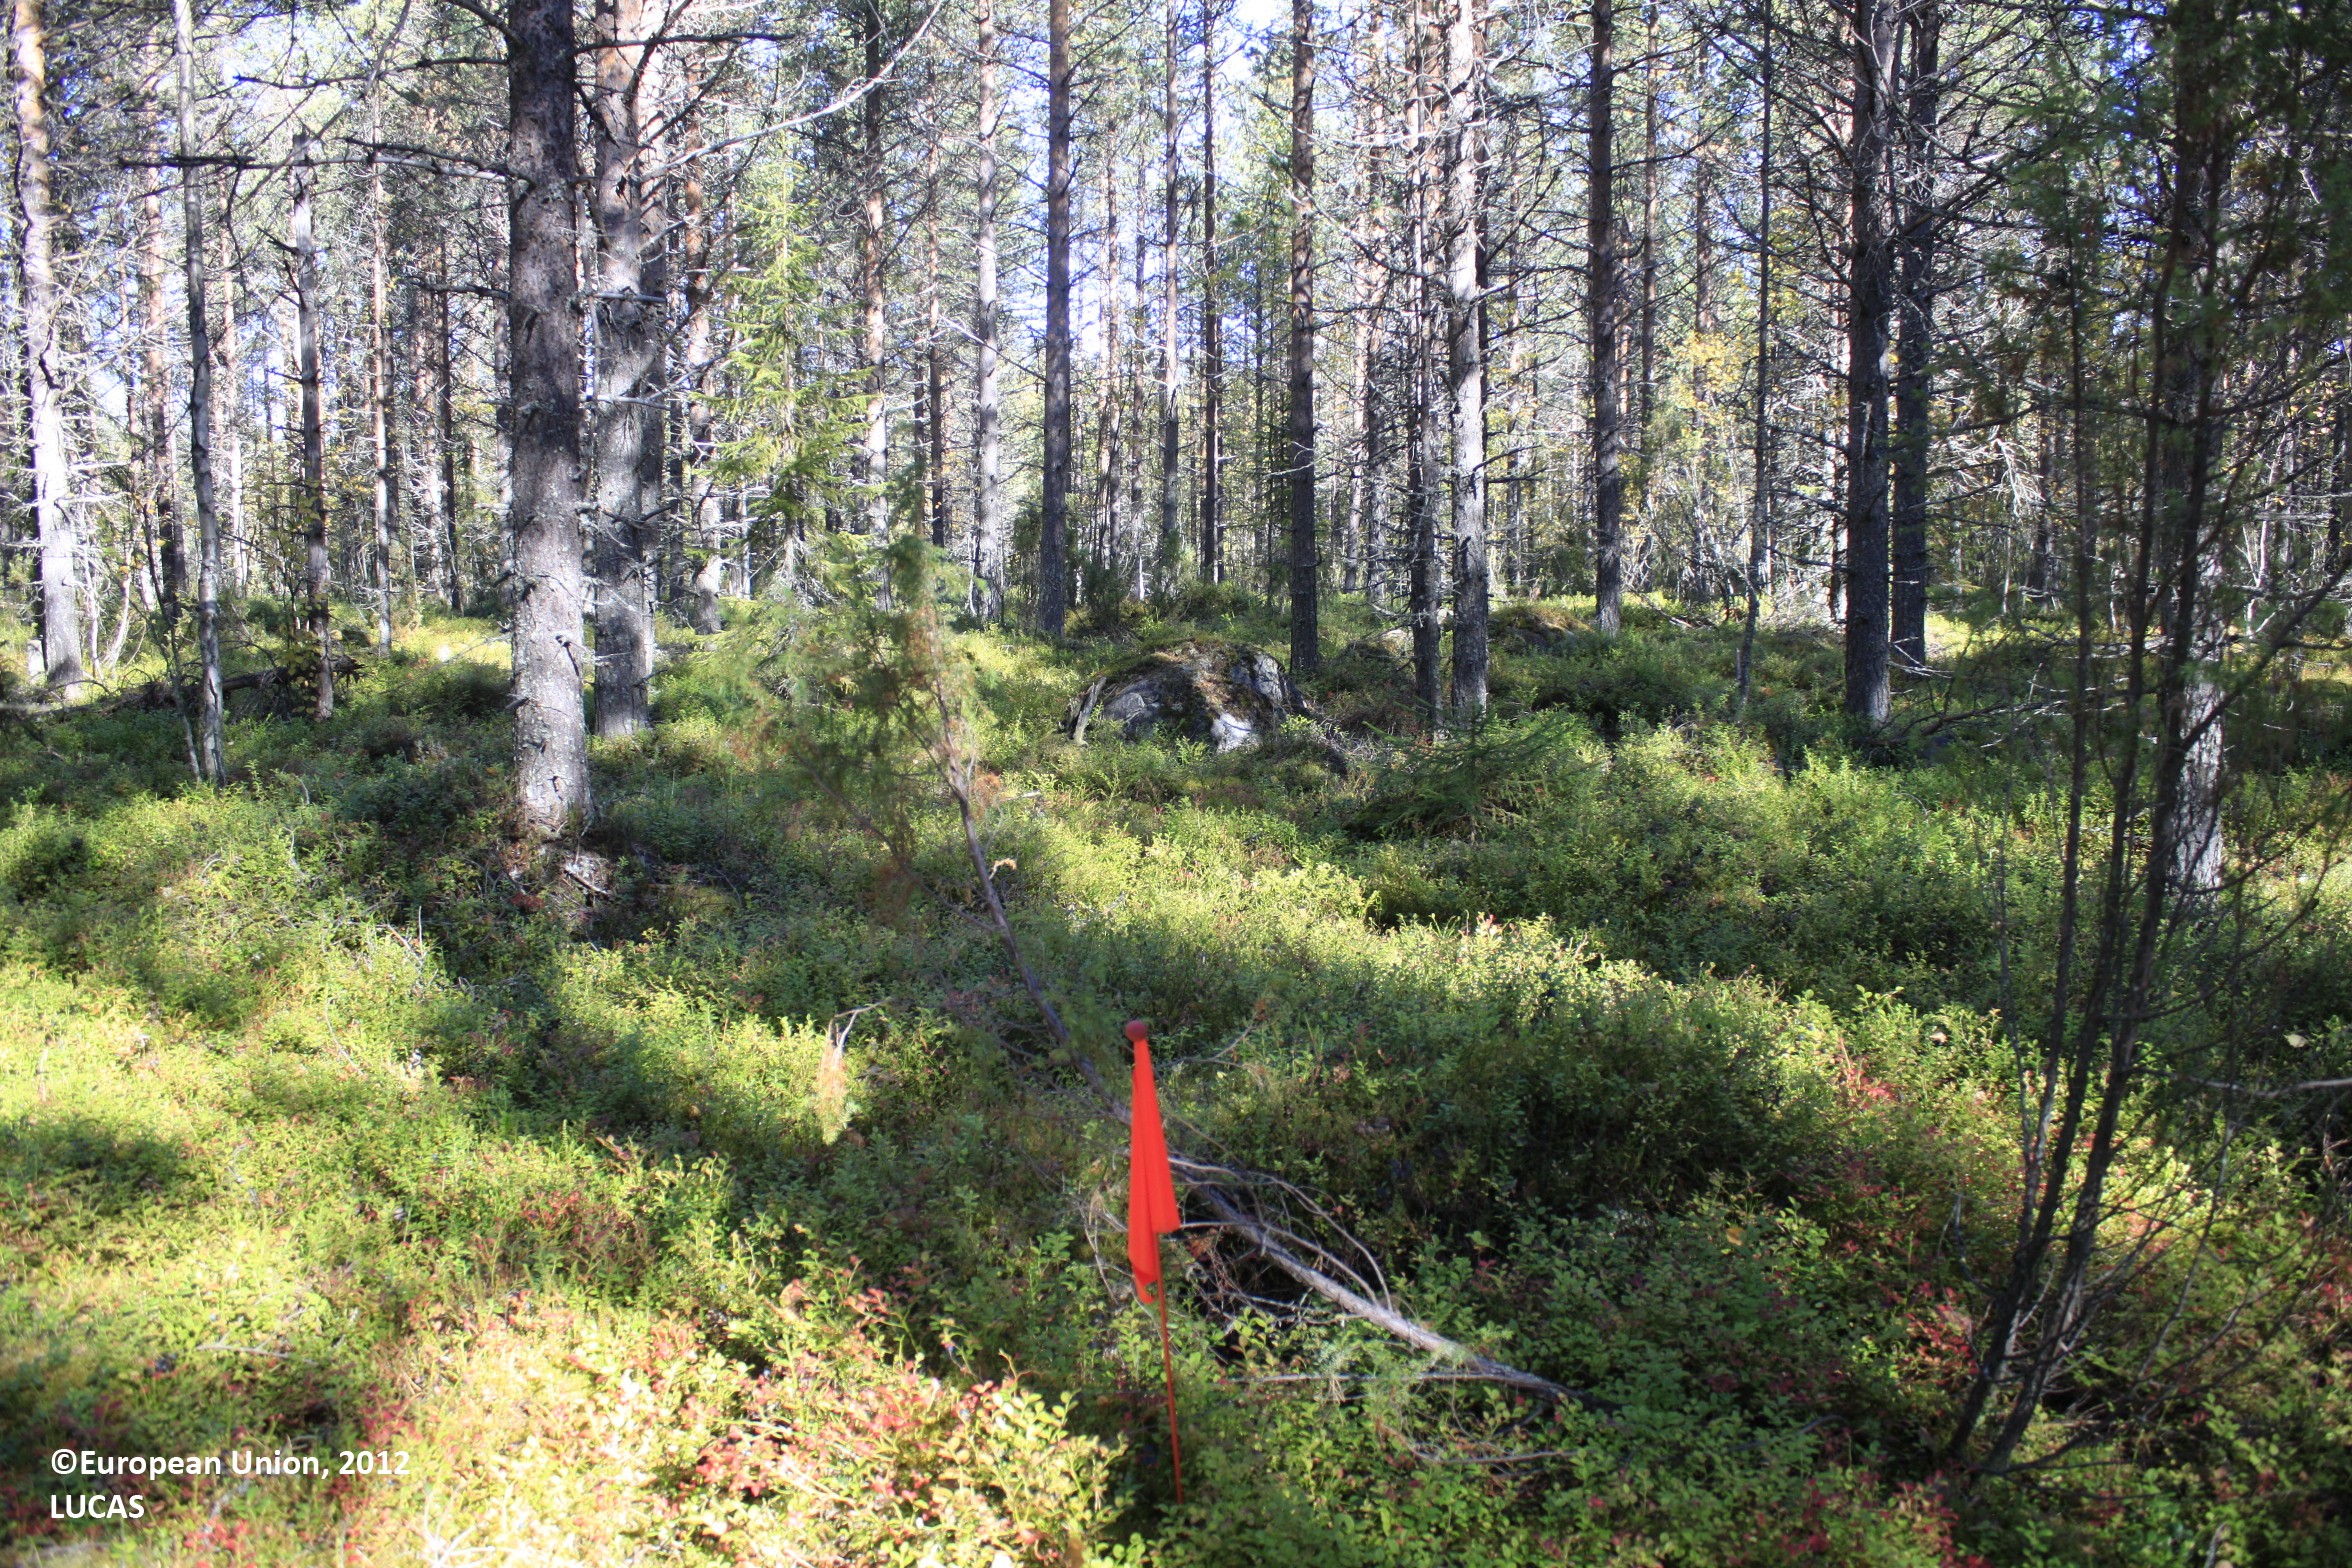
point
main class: Woodland
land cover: Pine dominated coniferous woodland
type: boreal forest
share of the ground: 25 - 50 %
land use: Forestry
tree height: > 5 m
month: September
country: FI
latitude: 65.8461
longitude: 26.8606
